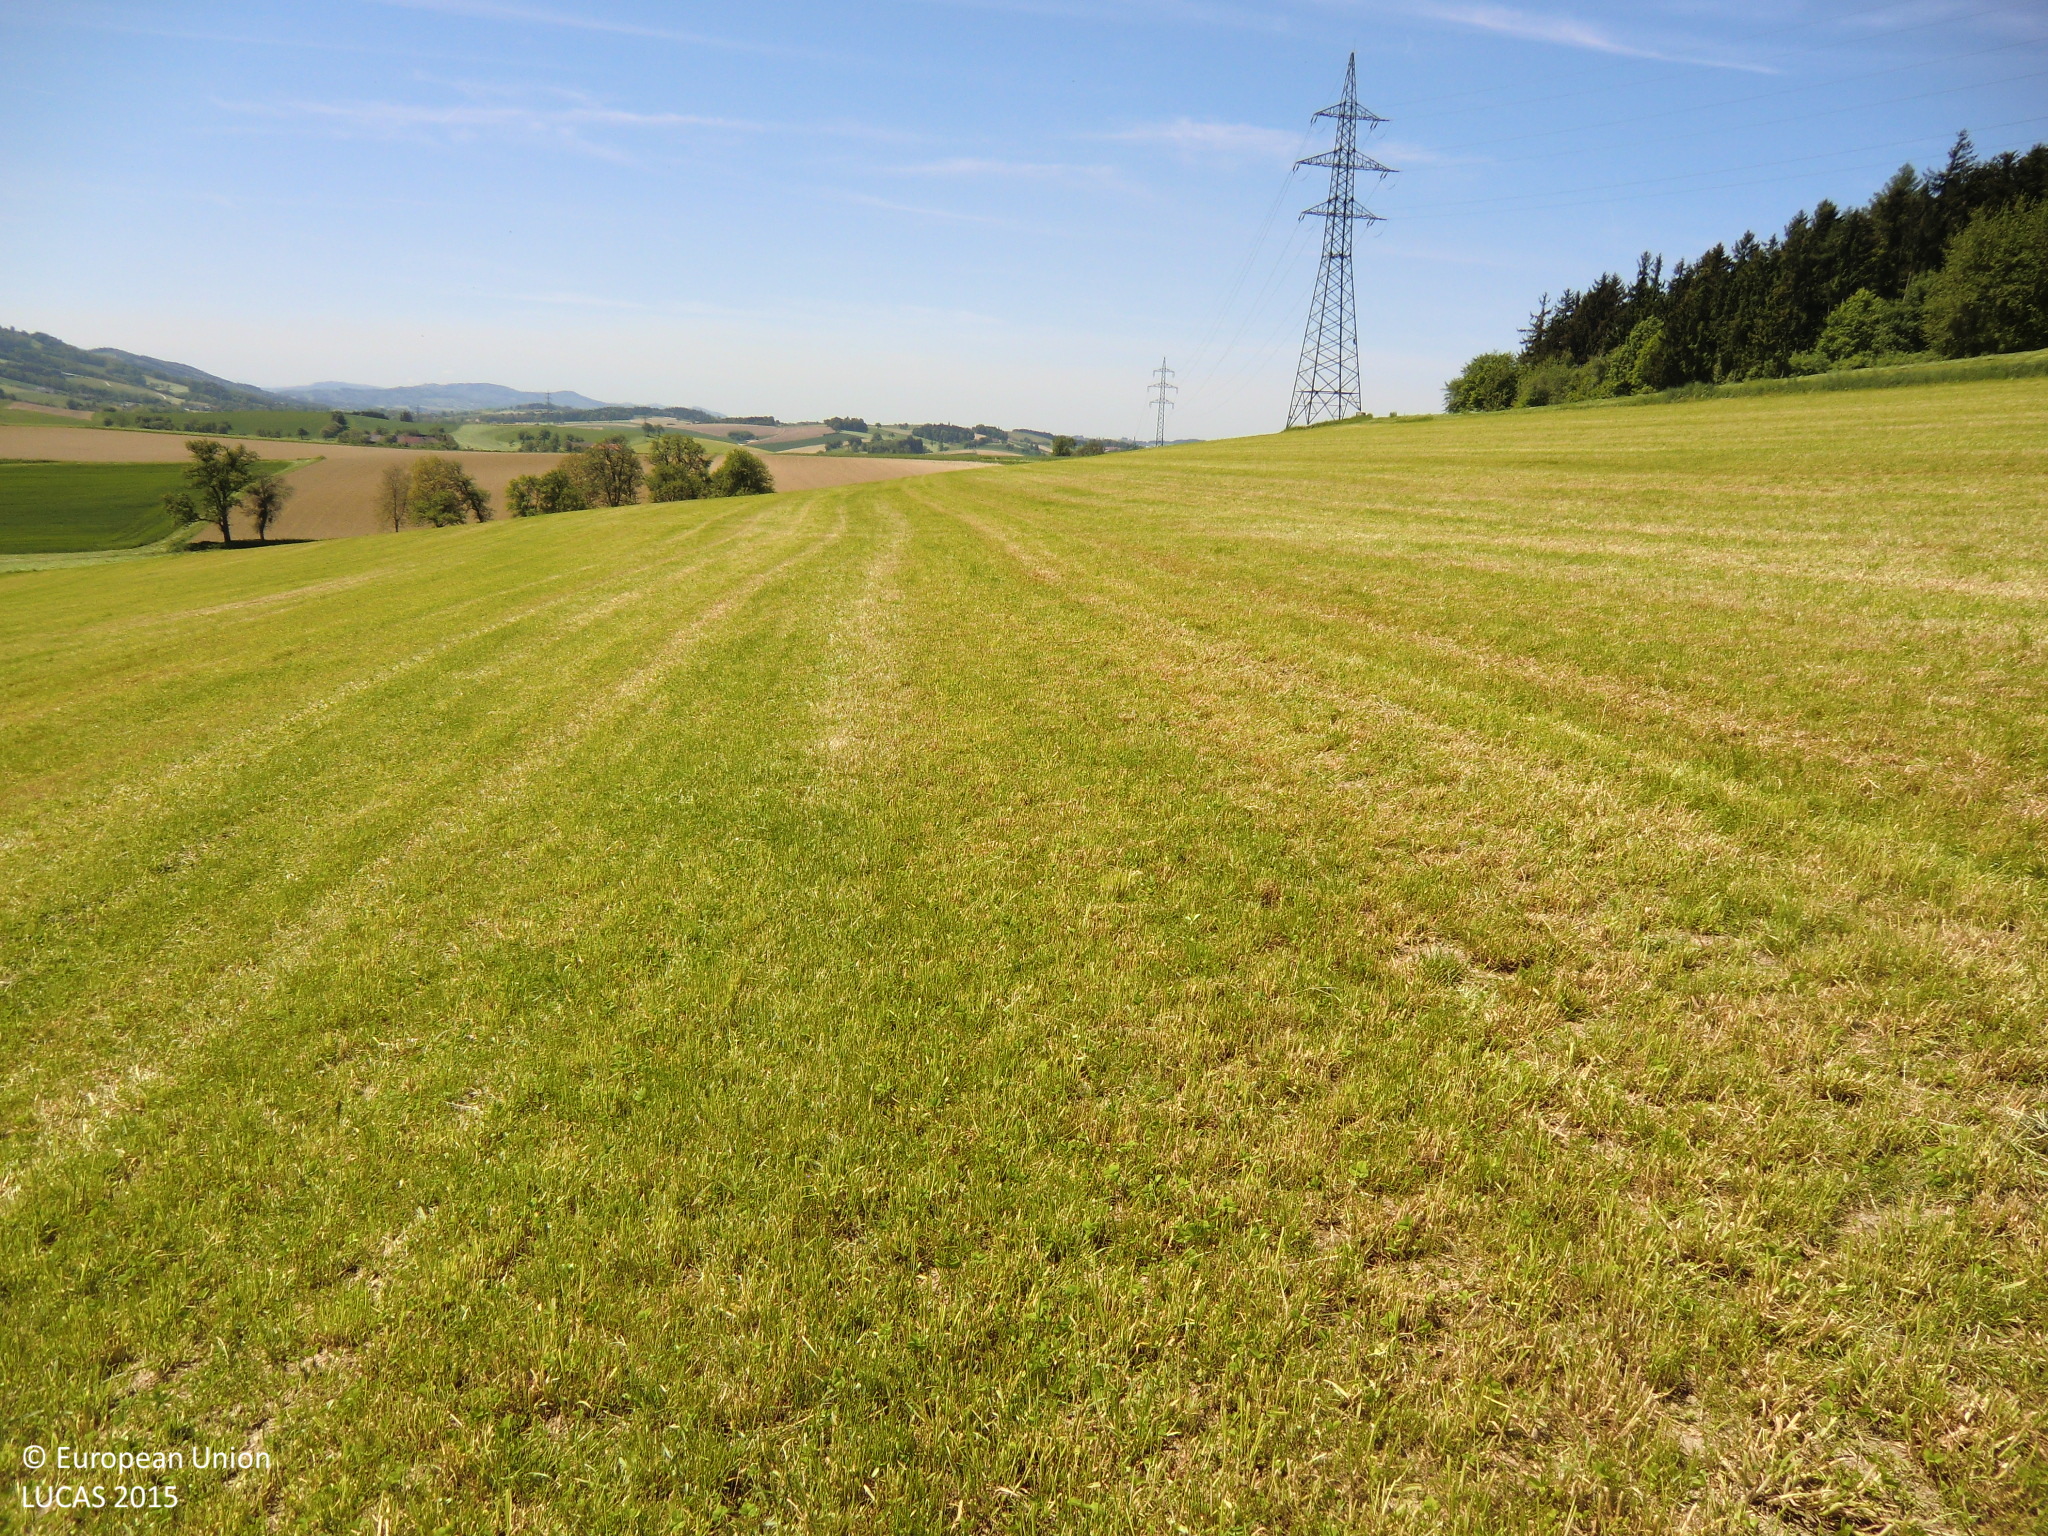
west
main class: Grassland
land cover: Grassland without tree/shrub cover
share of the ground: > 75 %
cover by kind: herbaceous plants 100 %
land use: Agriculture (excluding fallow land and kitchen gardens)
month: May
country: AT
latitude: 48.0766
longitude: 15.3304
